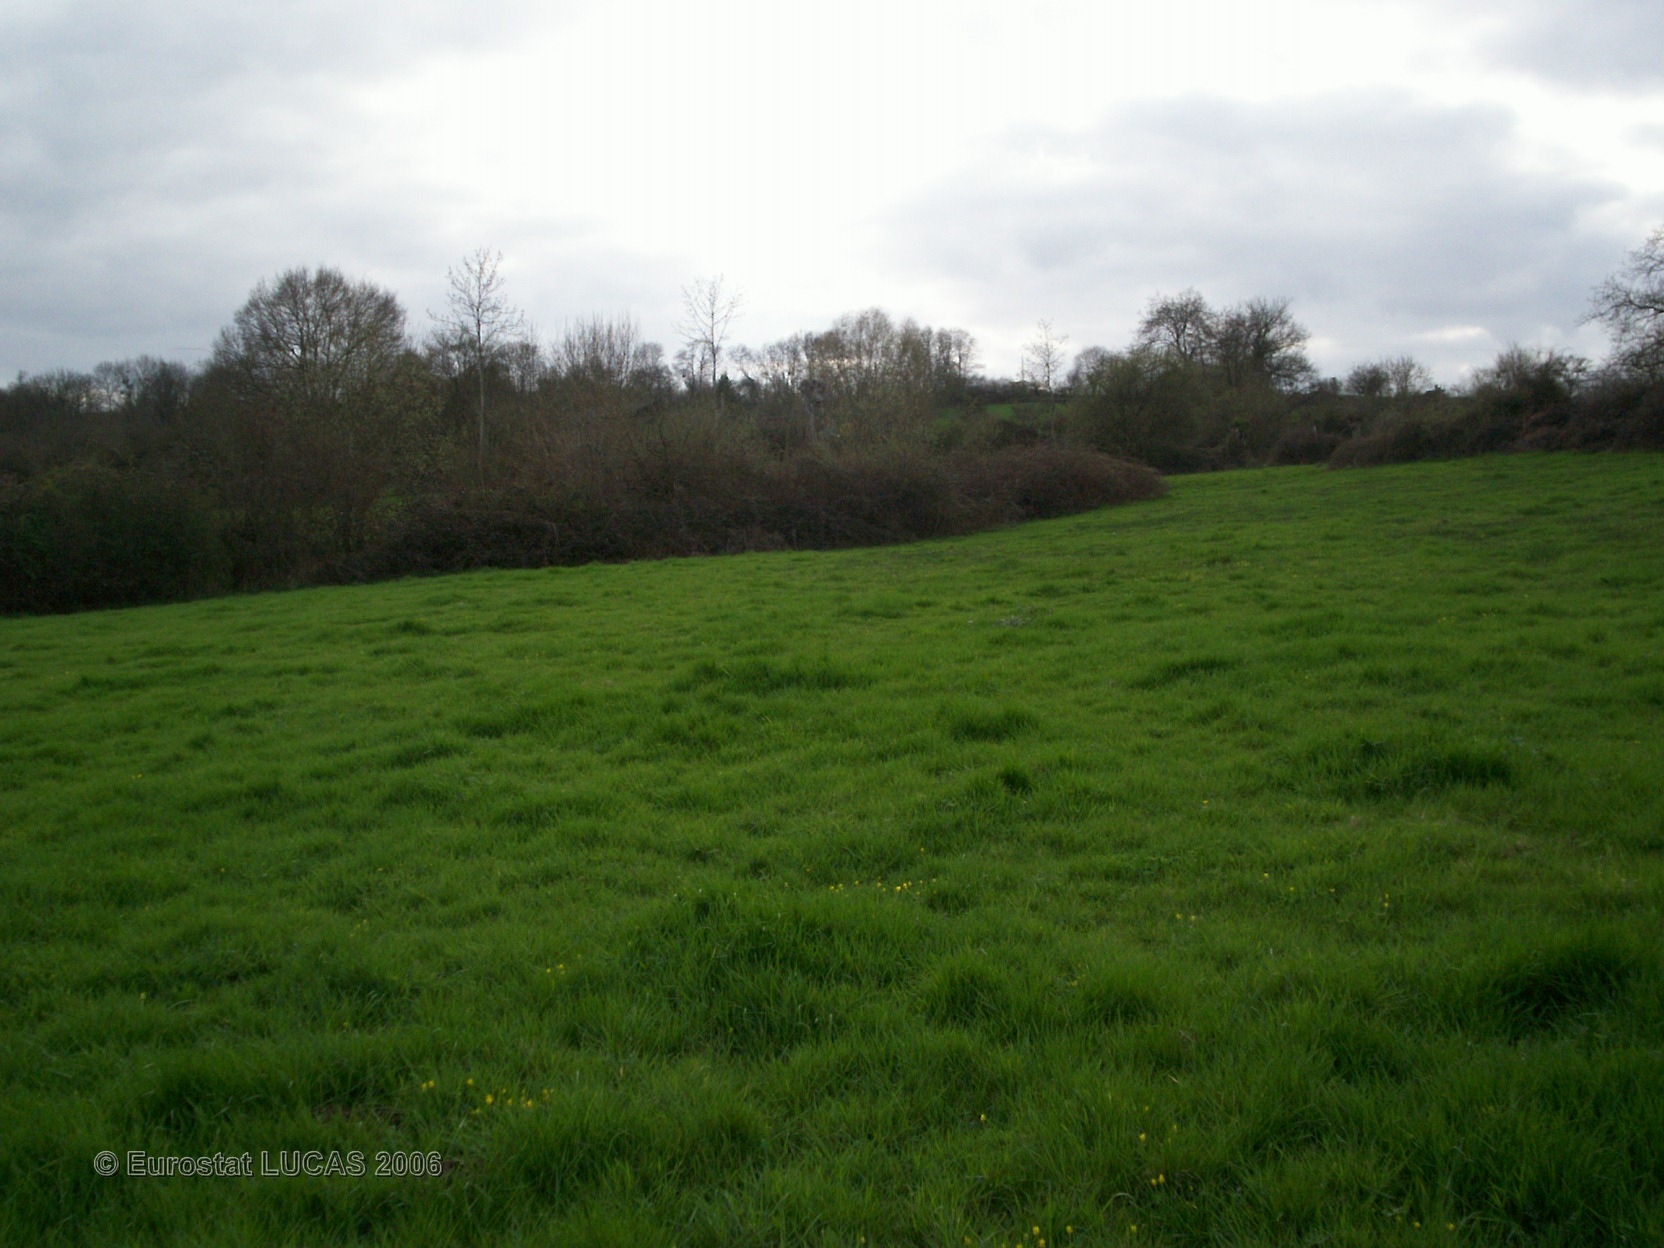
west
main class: Grassland
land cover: Grassland without tree/shrub cover
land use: Agriculture (excluding fallow land and kitchen gardens)
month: April
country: FR
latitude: 48.8989
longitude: 0.0804
